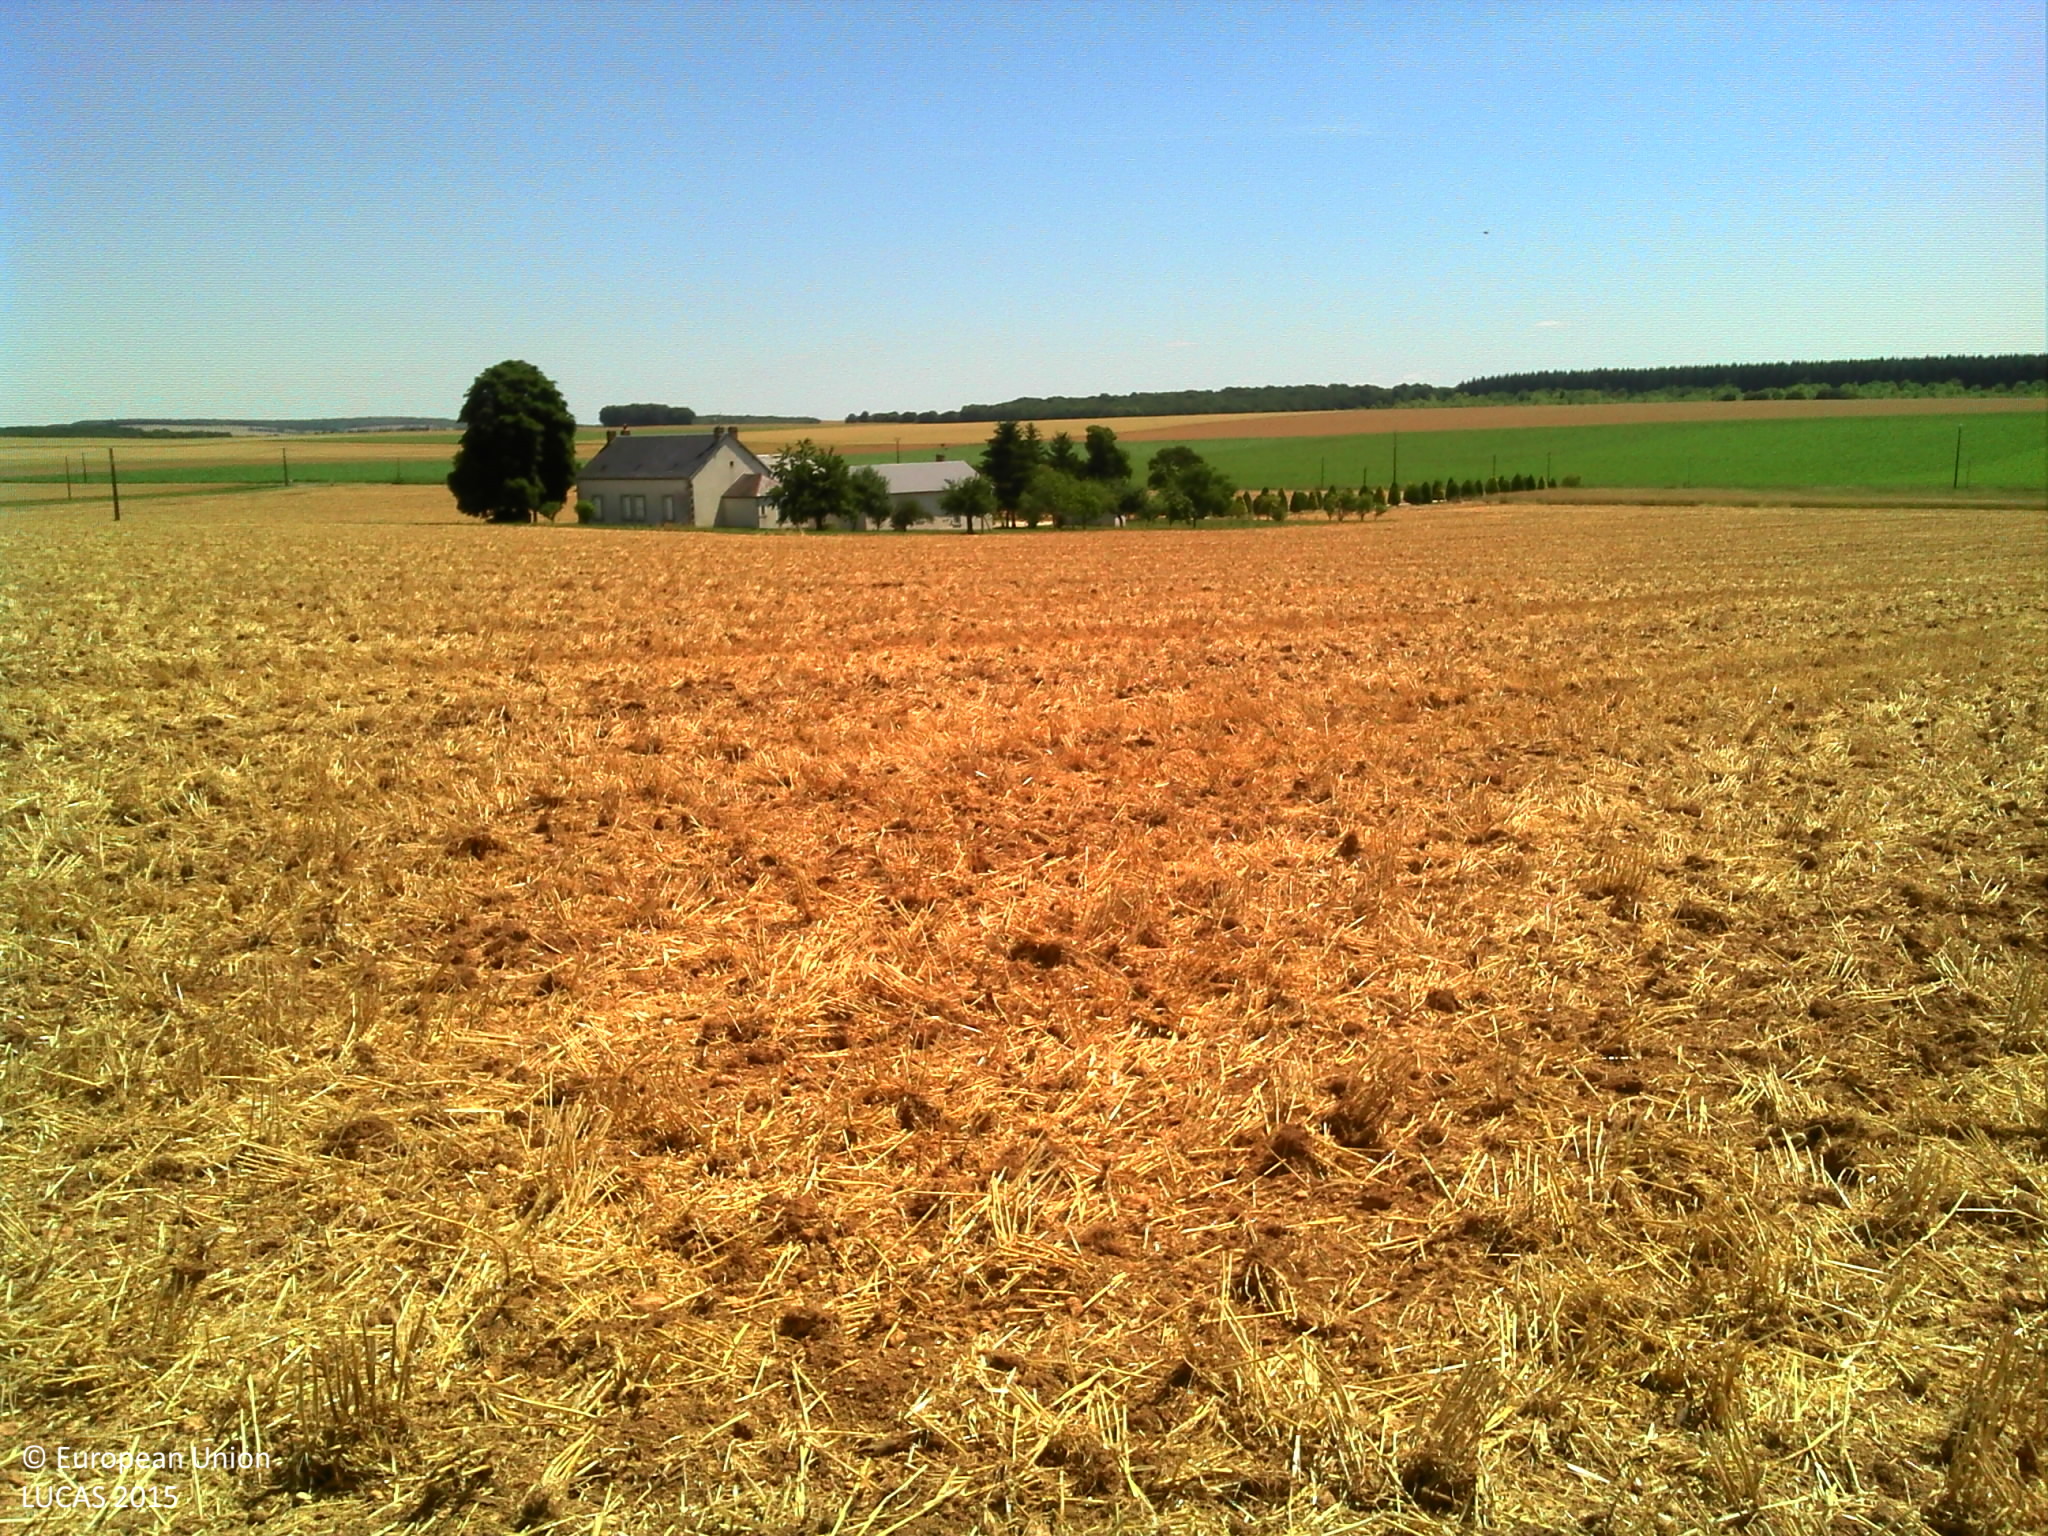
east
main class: Cropland
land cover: Barley
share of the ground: > 75 %
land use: Agriculture (excluding fallow land and kitchen gardens)
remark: Harvested field
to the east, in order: Barley; Artificial constructions in urban areas; Barley
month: June
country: FR
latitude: 47.1986
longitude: 2.6146
